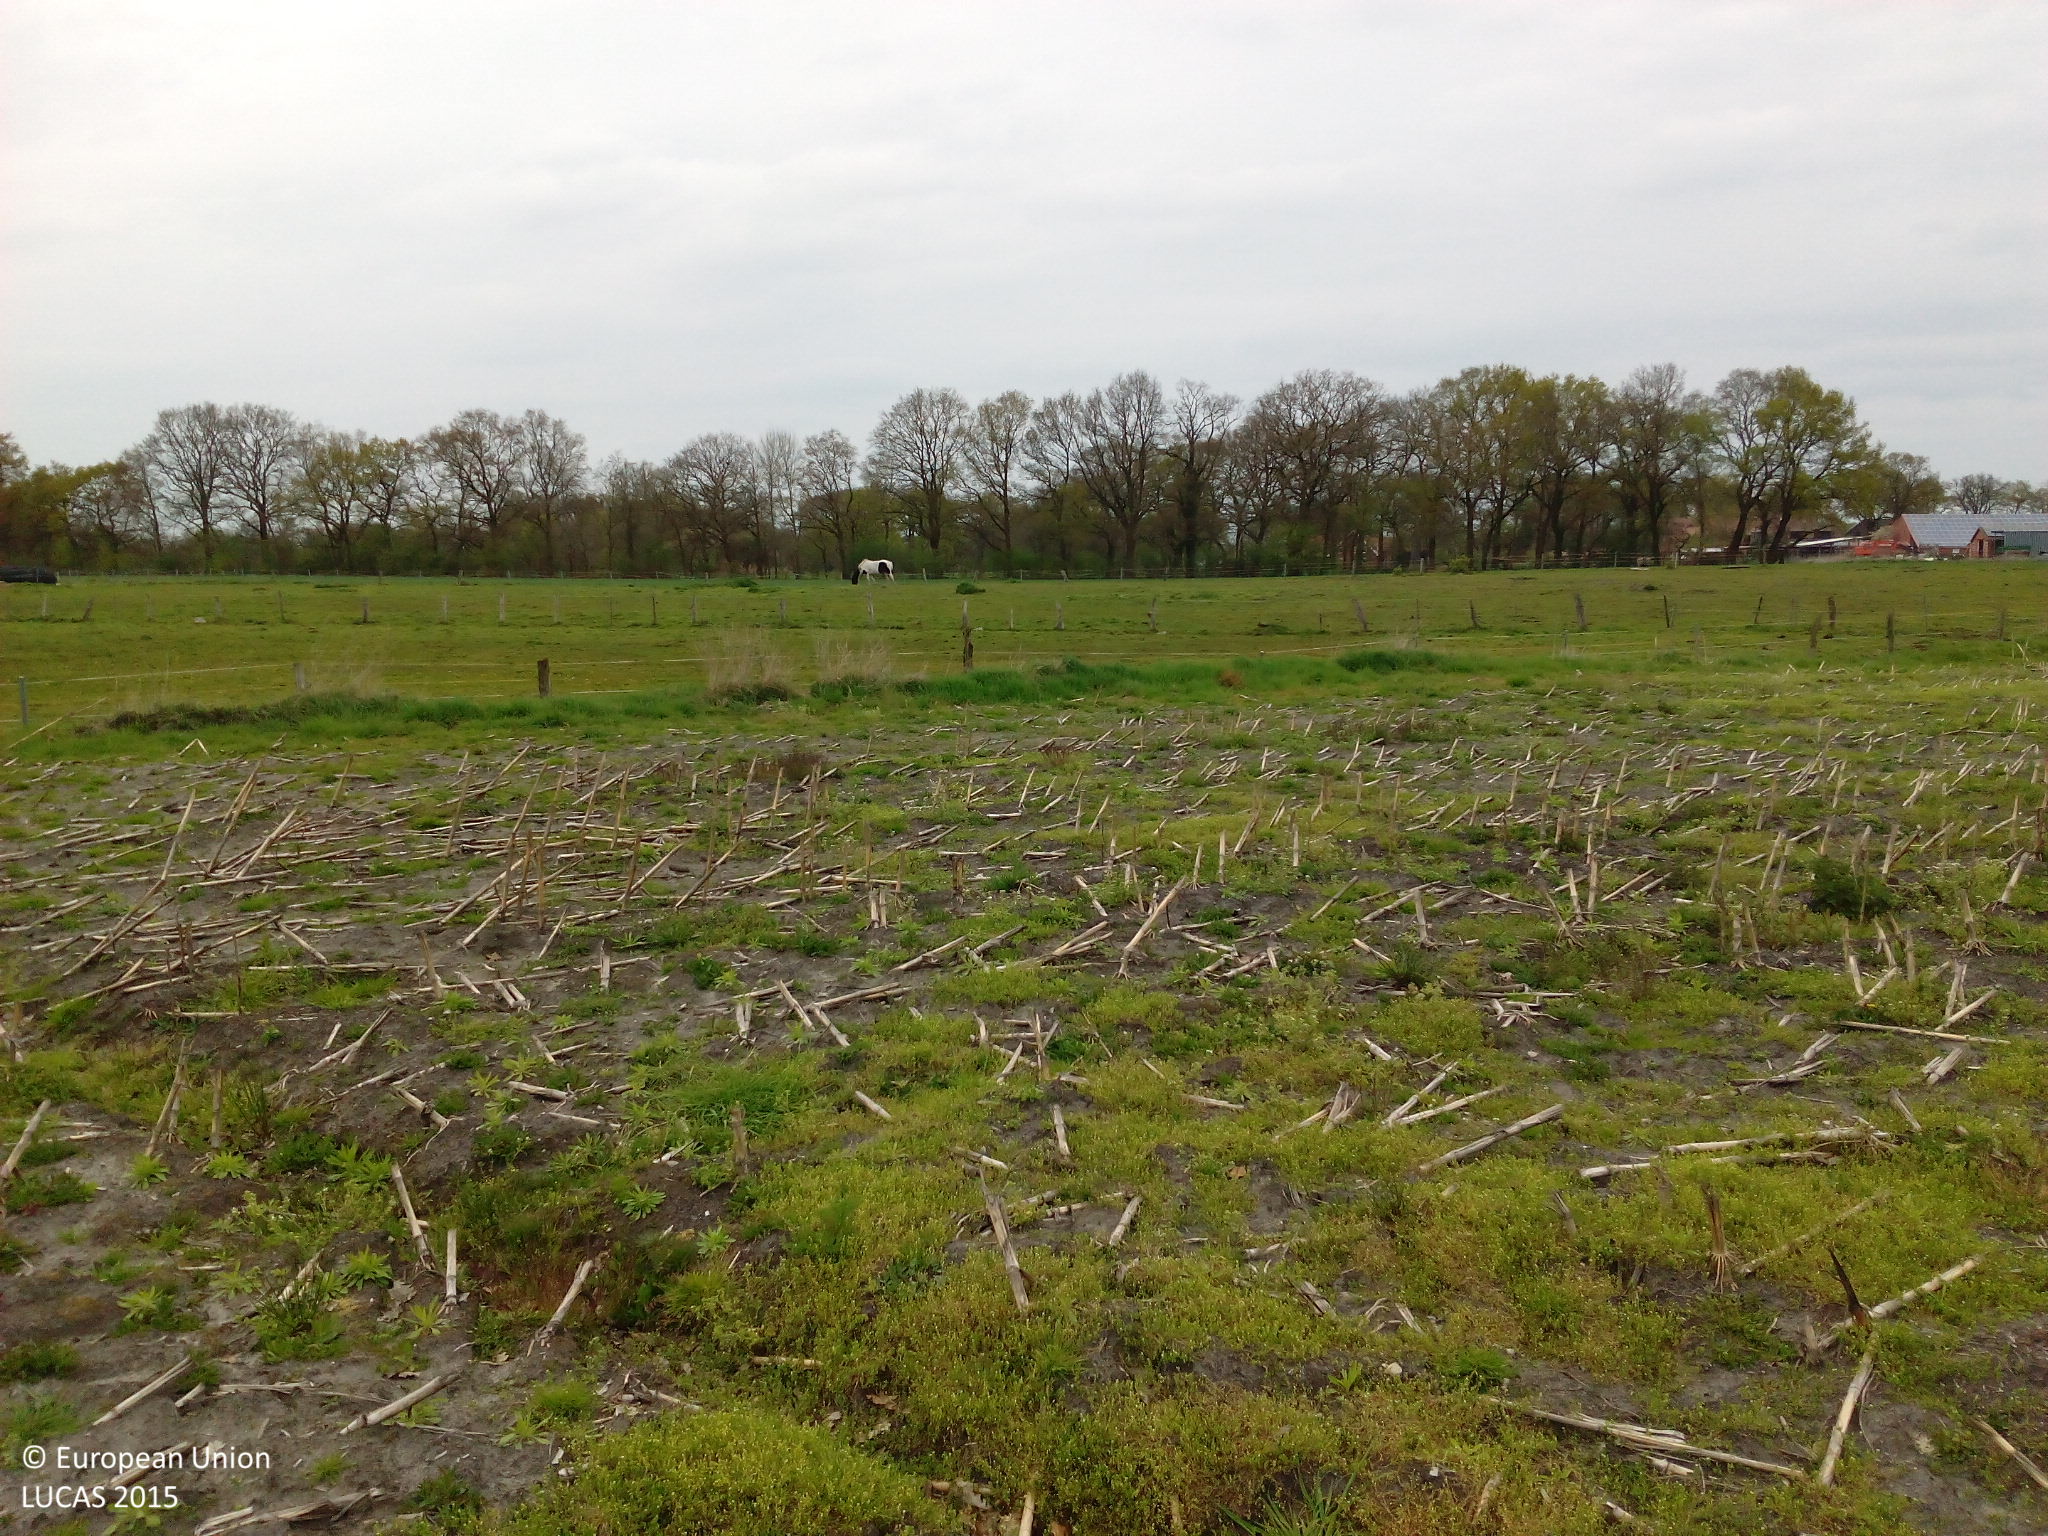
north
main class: Grassland
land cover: Spontaneously vegetated surfaces
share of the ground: 50 - 75 %
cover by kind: herbaceous plants 50 %, consolidated bare surface 30 %, lichens and mosses 20 %
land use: Fallow land
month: May
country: DE
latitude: 53.2498
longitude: 8.5768
